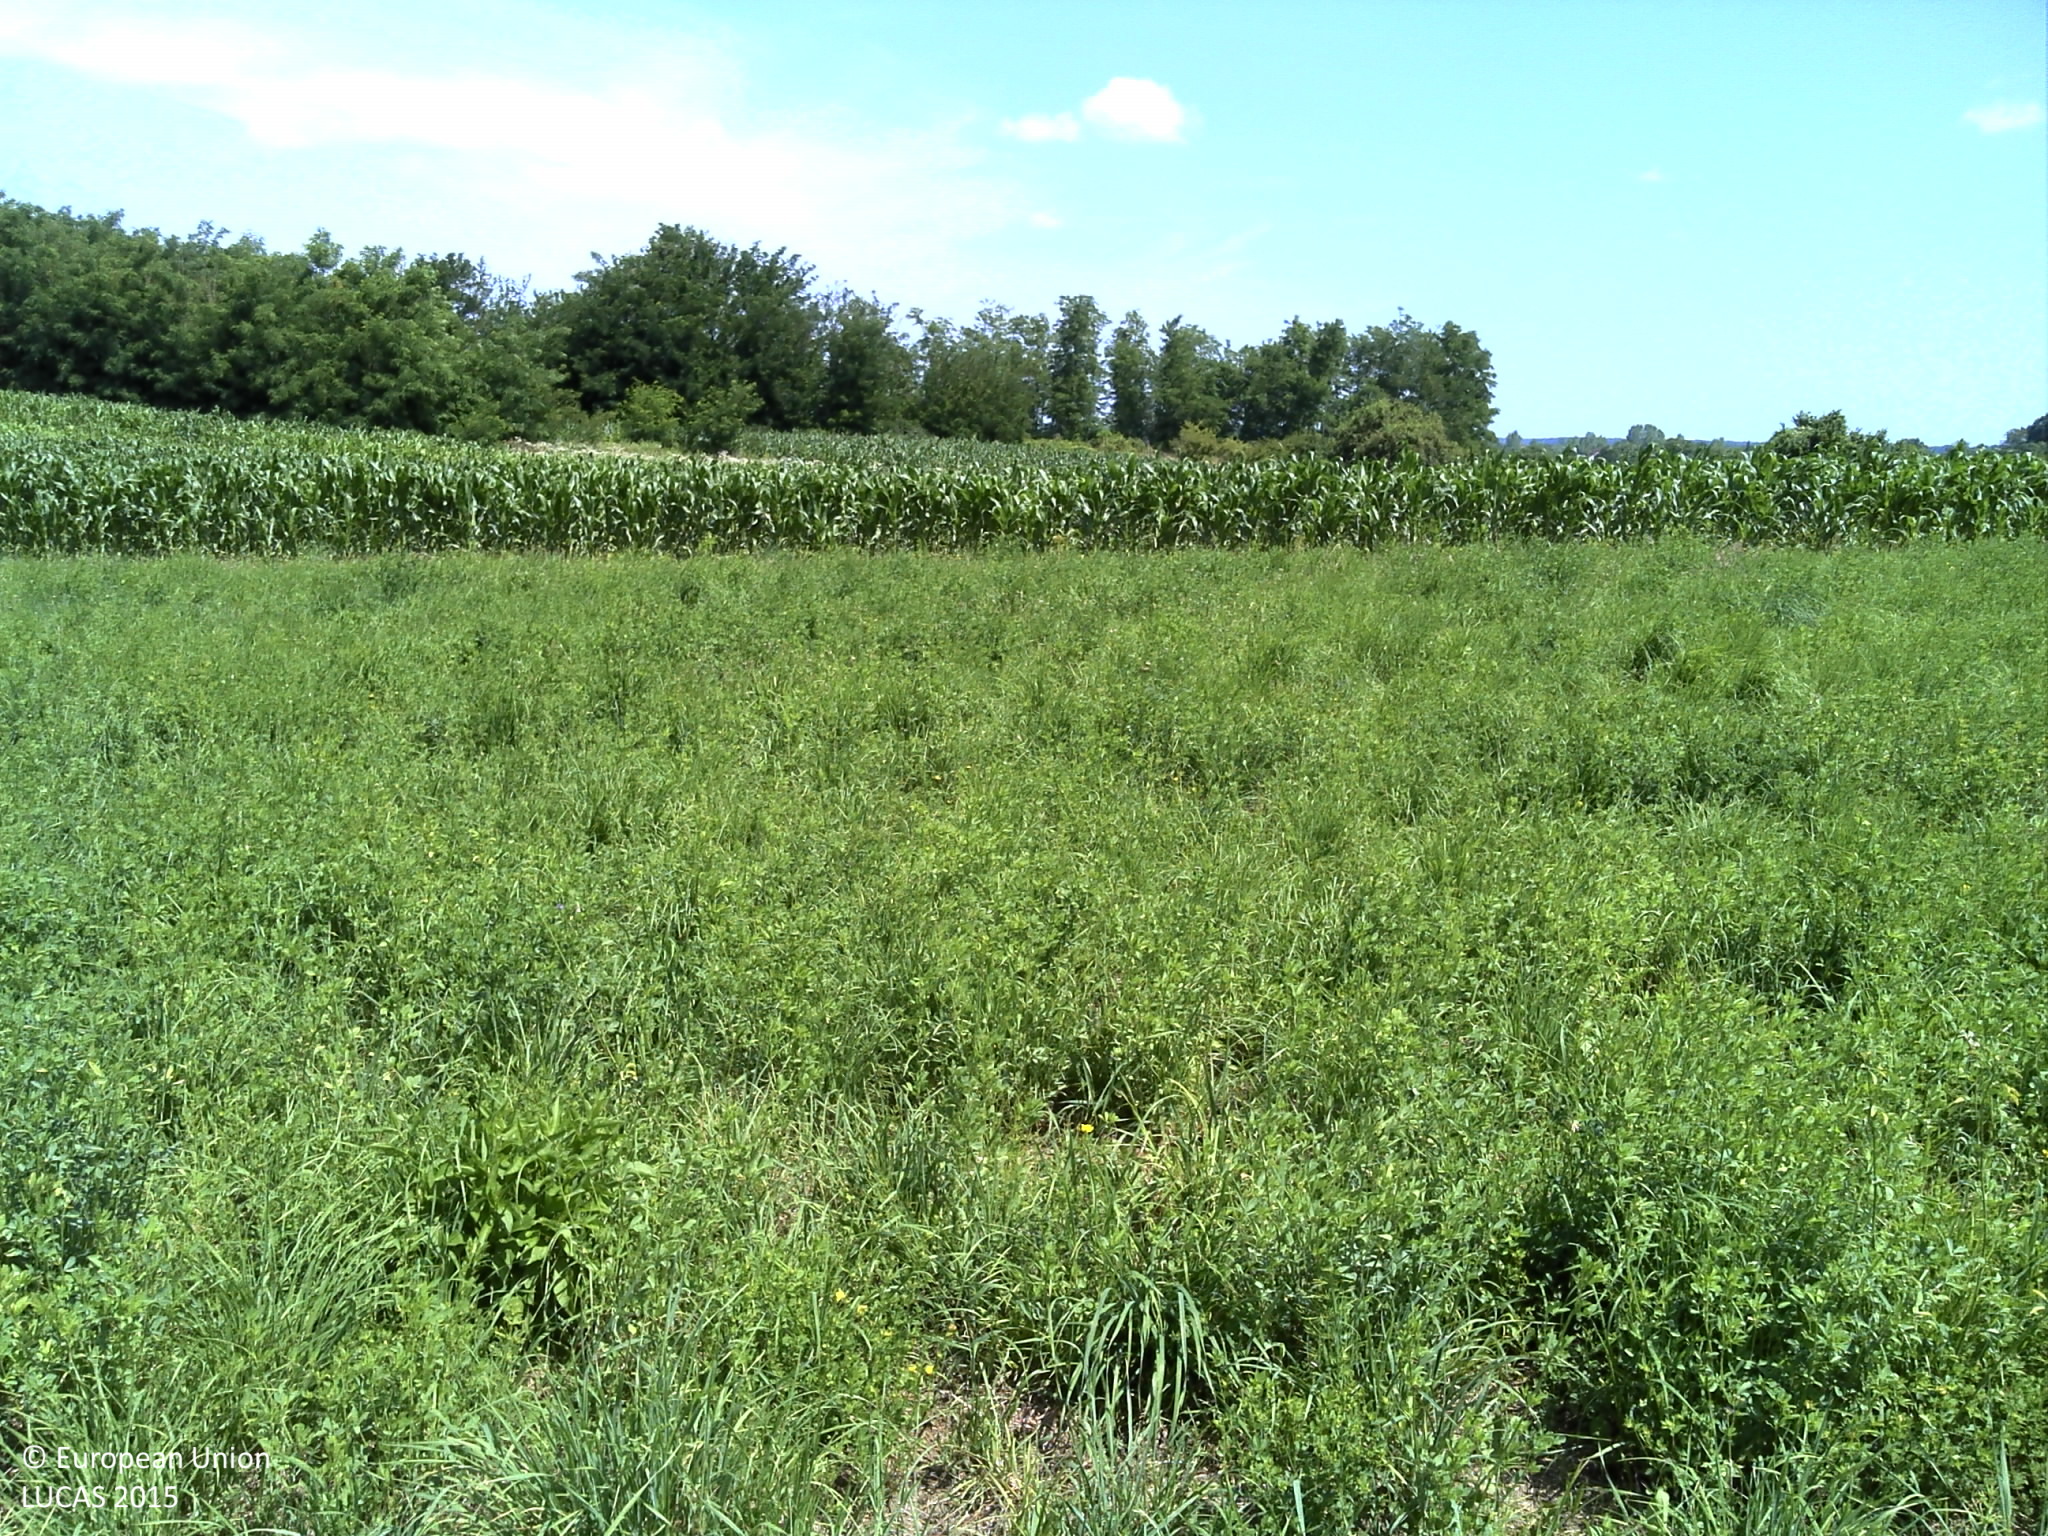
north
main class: Grassland
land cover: Spontaneously vegetated surfaces
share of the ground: > 75 %
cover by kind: herbaceous plants 100 %
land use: Semi-natural and natural areas not in use
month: June
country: HR
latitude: 45.9448
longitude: 17.2128
